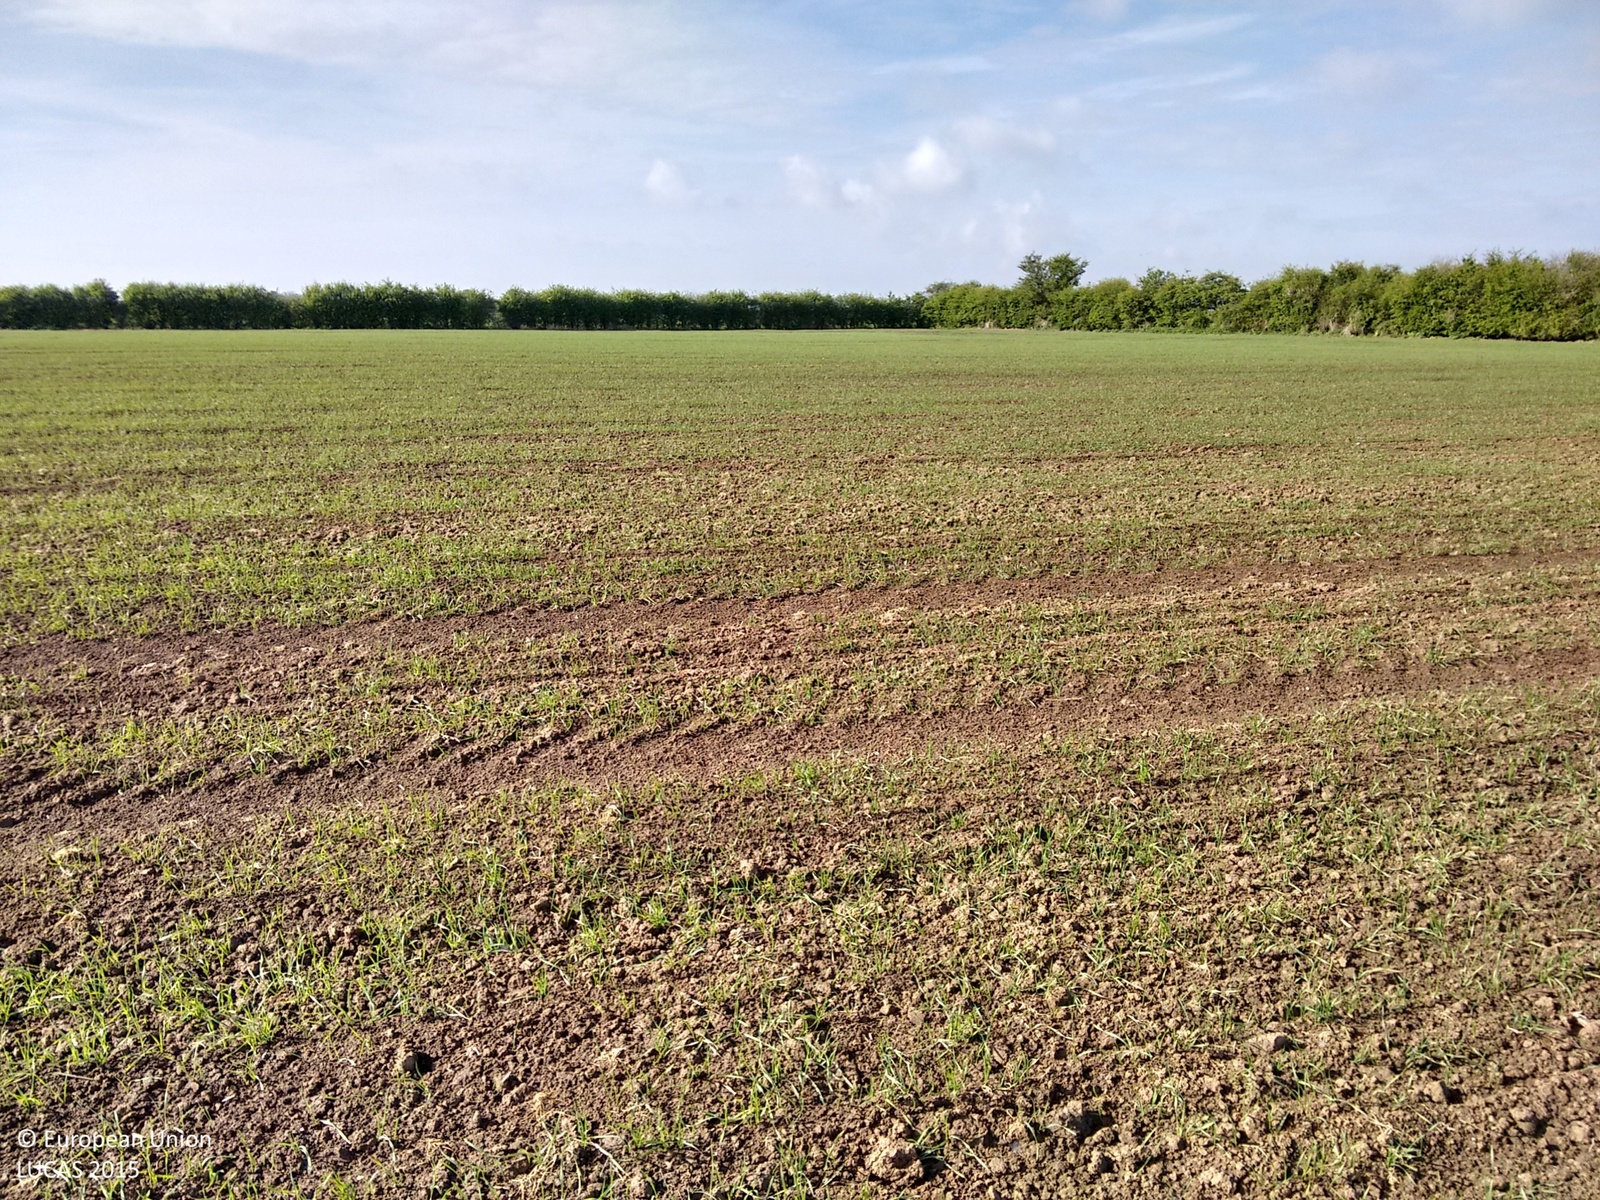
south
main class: Cropland
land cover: Common wheat
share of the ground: < 10 %
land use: Agriculture (excluding fallow land and kitchen gardens)
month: May
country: GB
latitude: 53.2807
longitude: 0.2670
